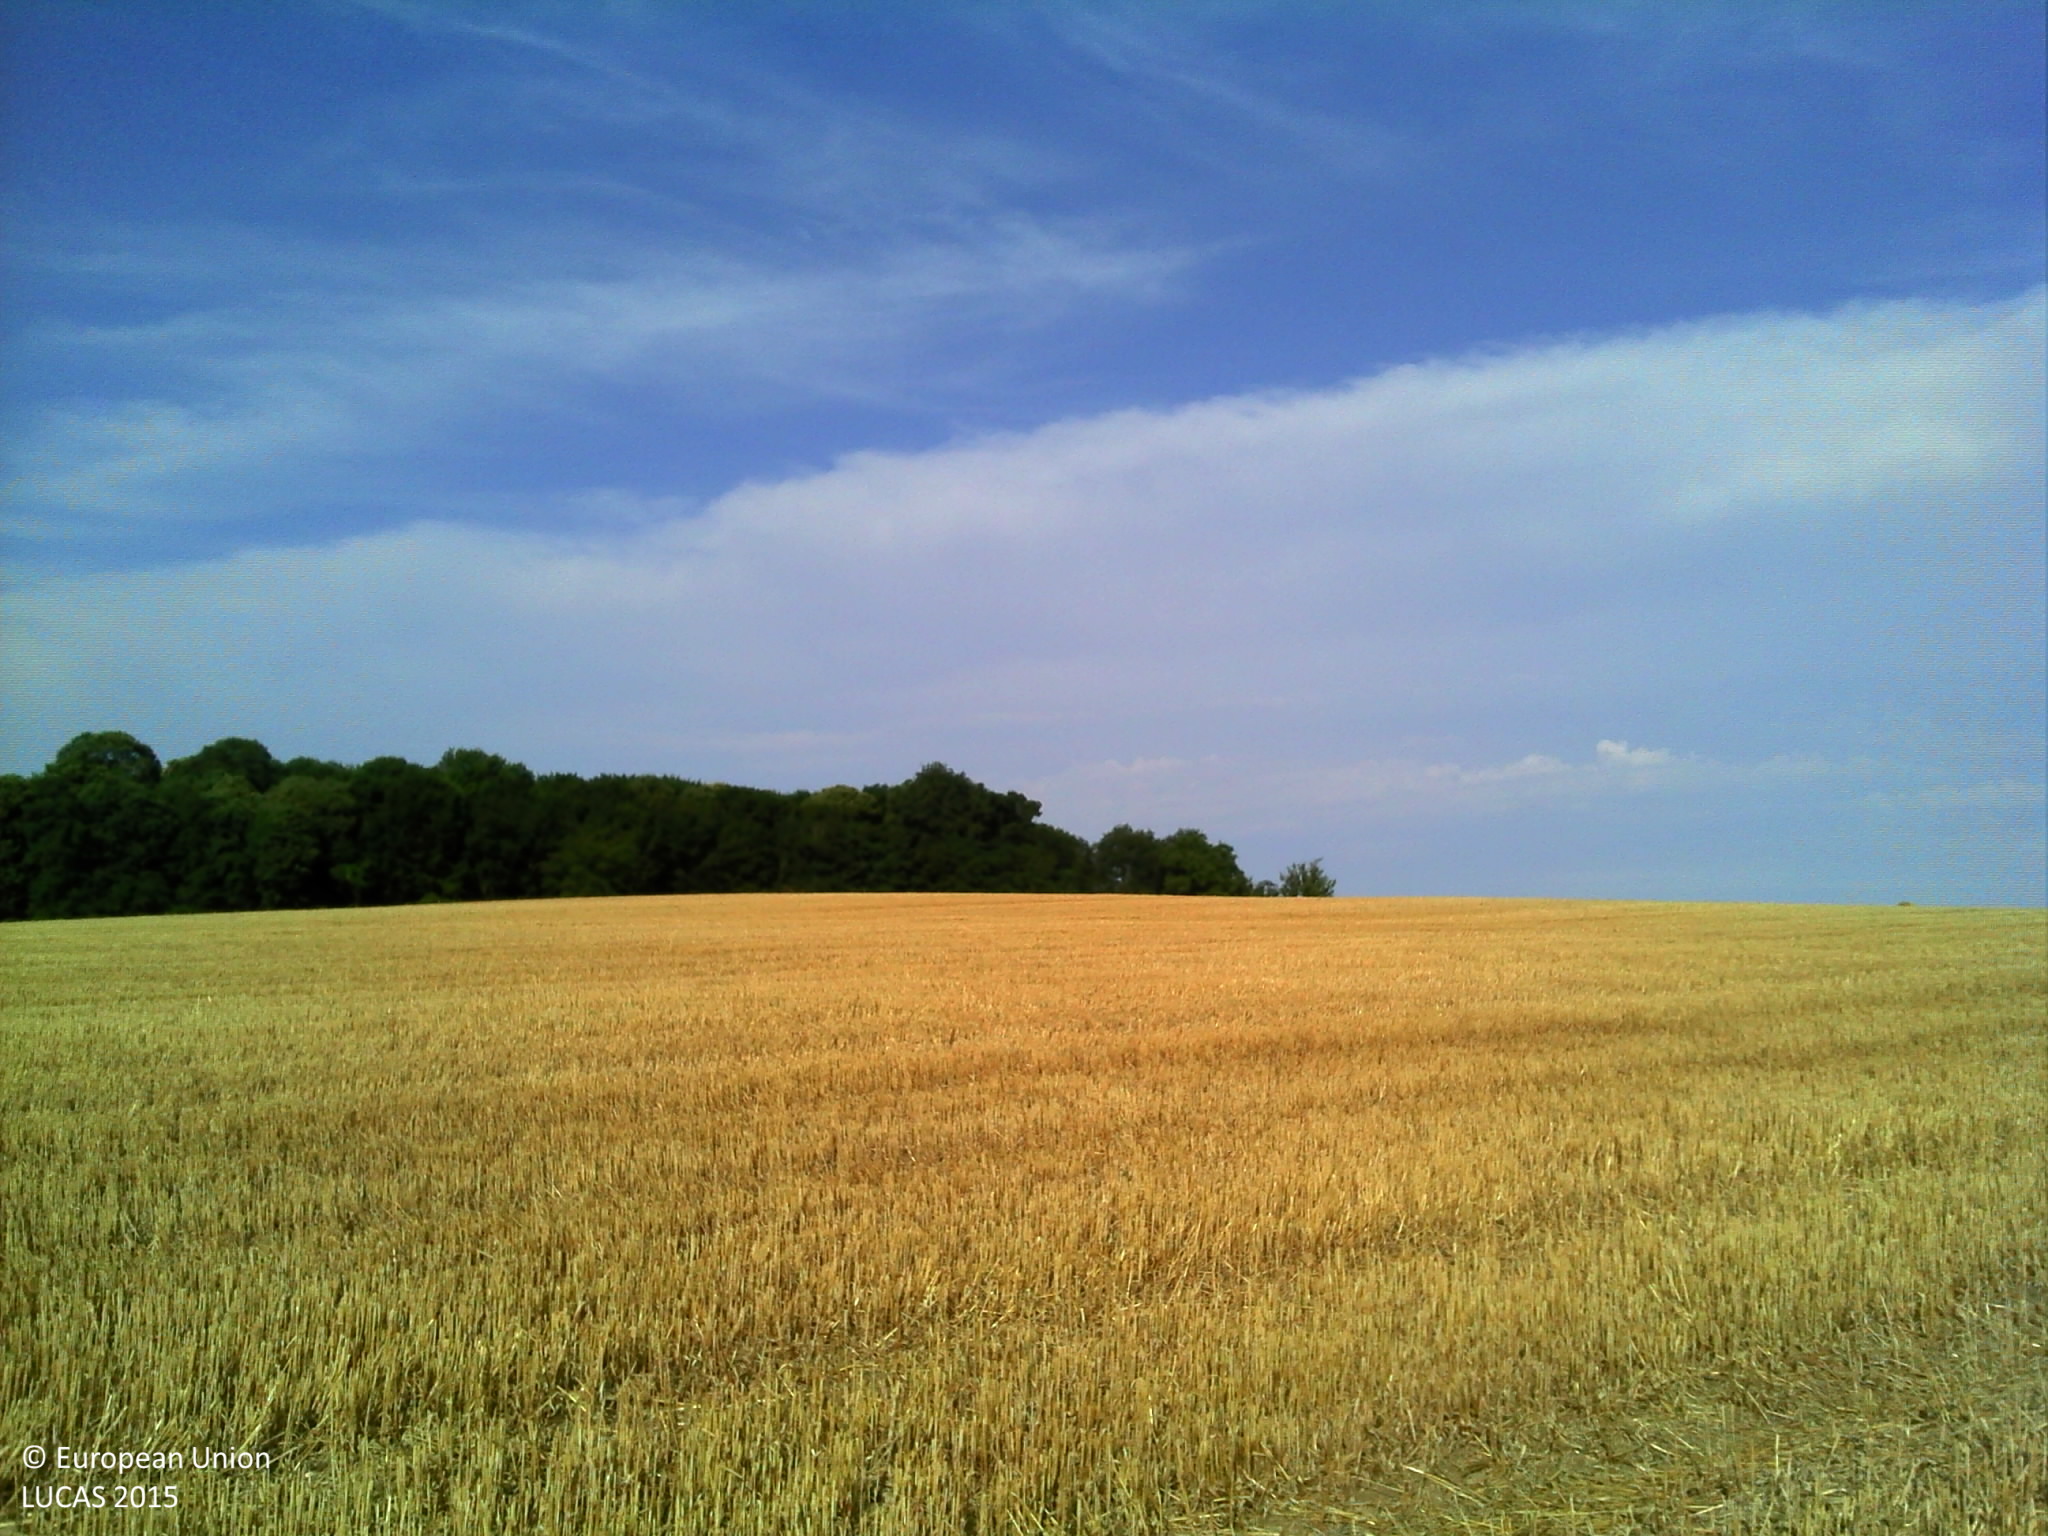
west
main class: Cropland
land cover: Barley
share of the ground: > 75 %
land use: Agriculture (excluding fallow land and kitchen gardens)
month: July
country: FR
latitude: 48.1301
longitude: 0.6121
